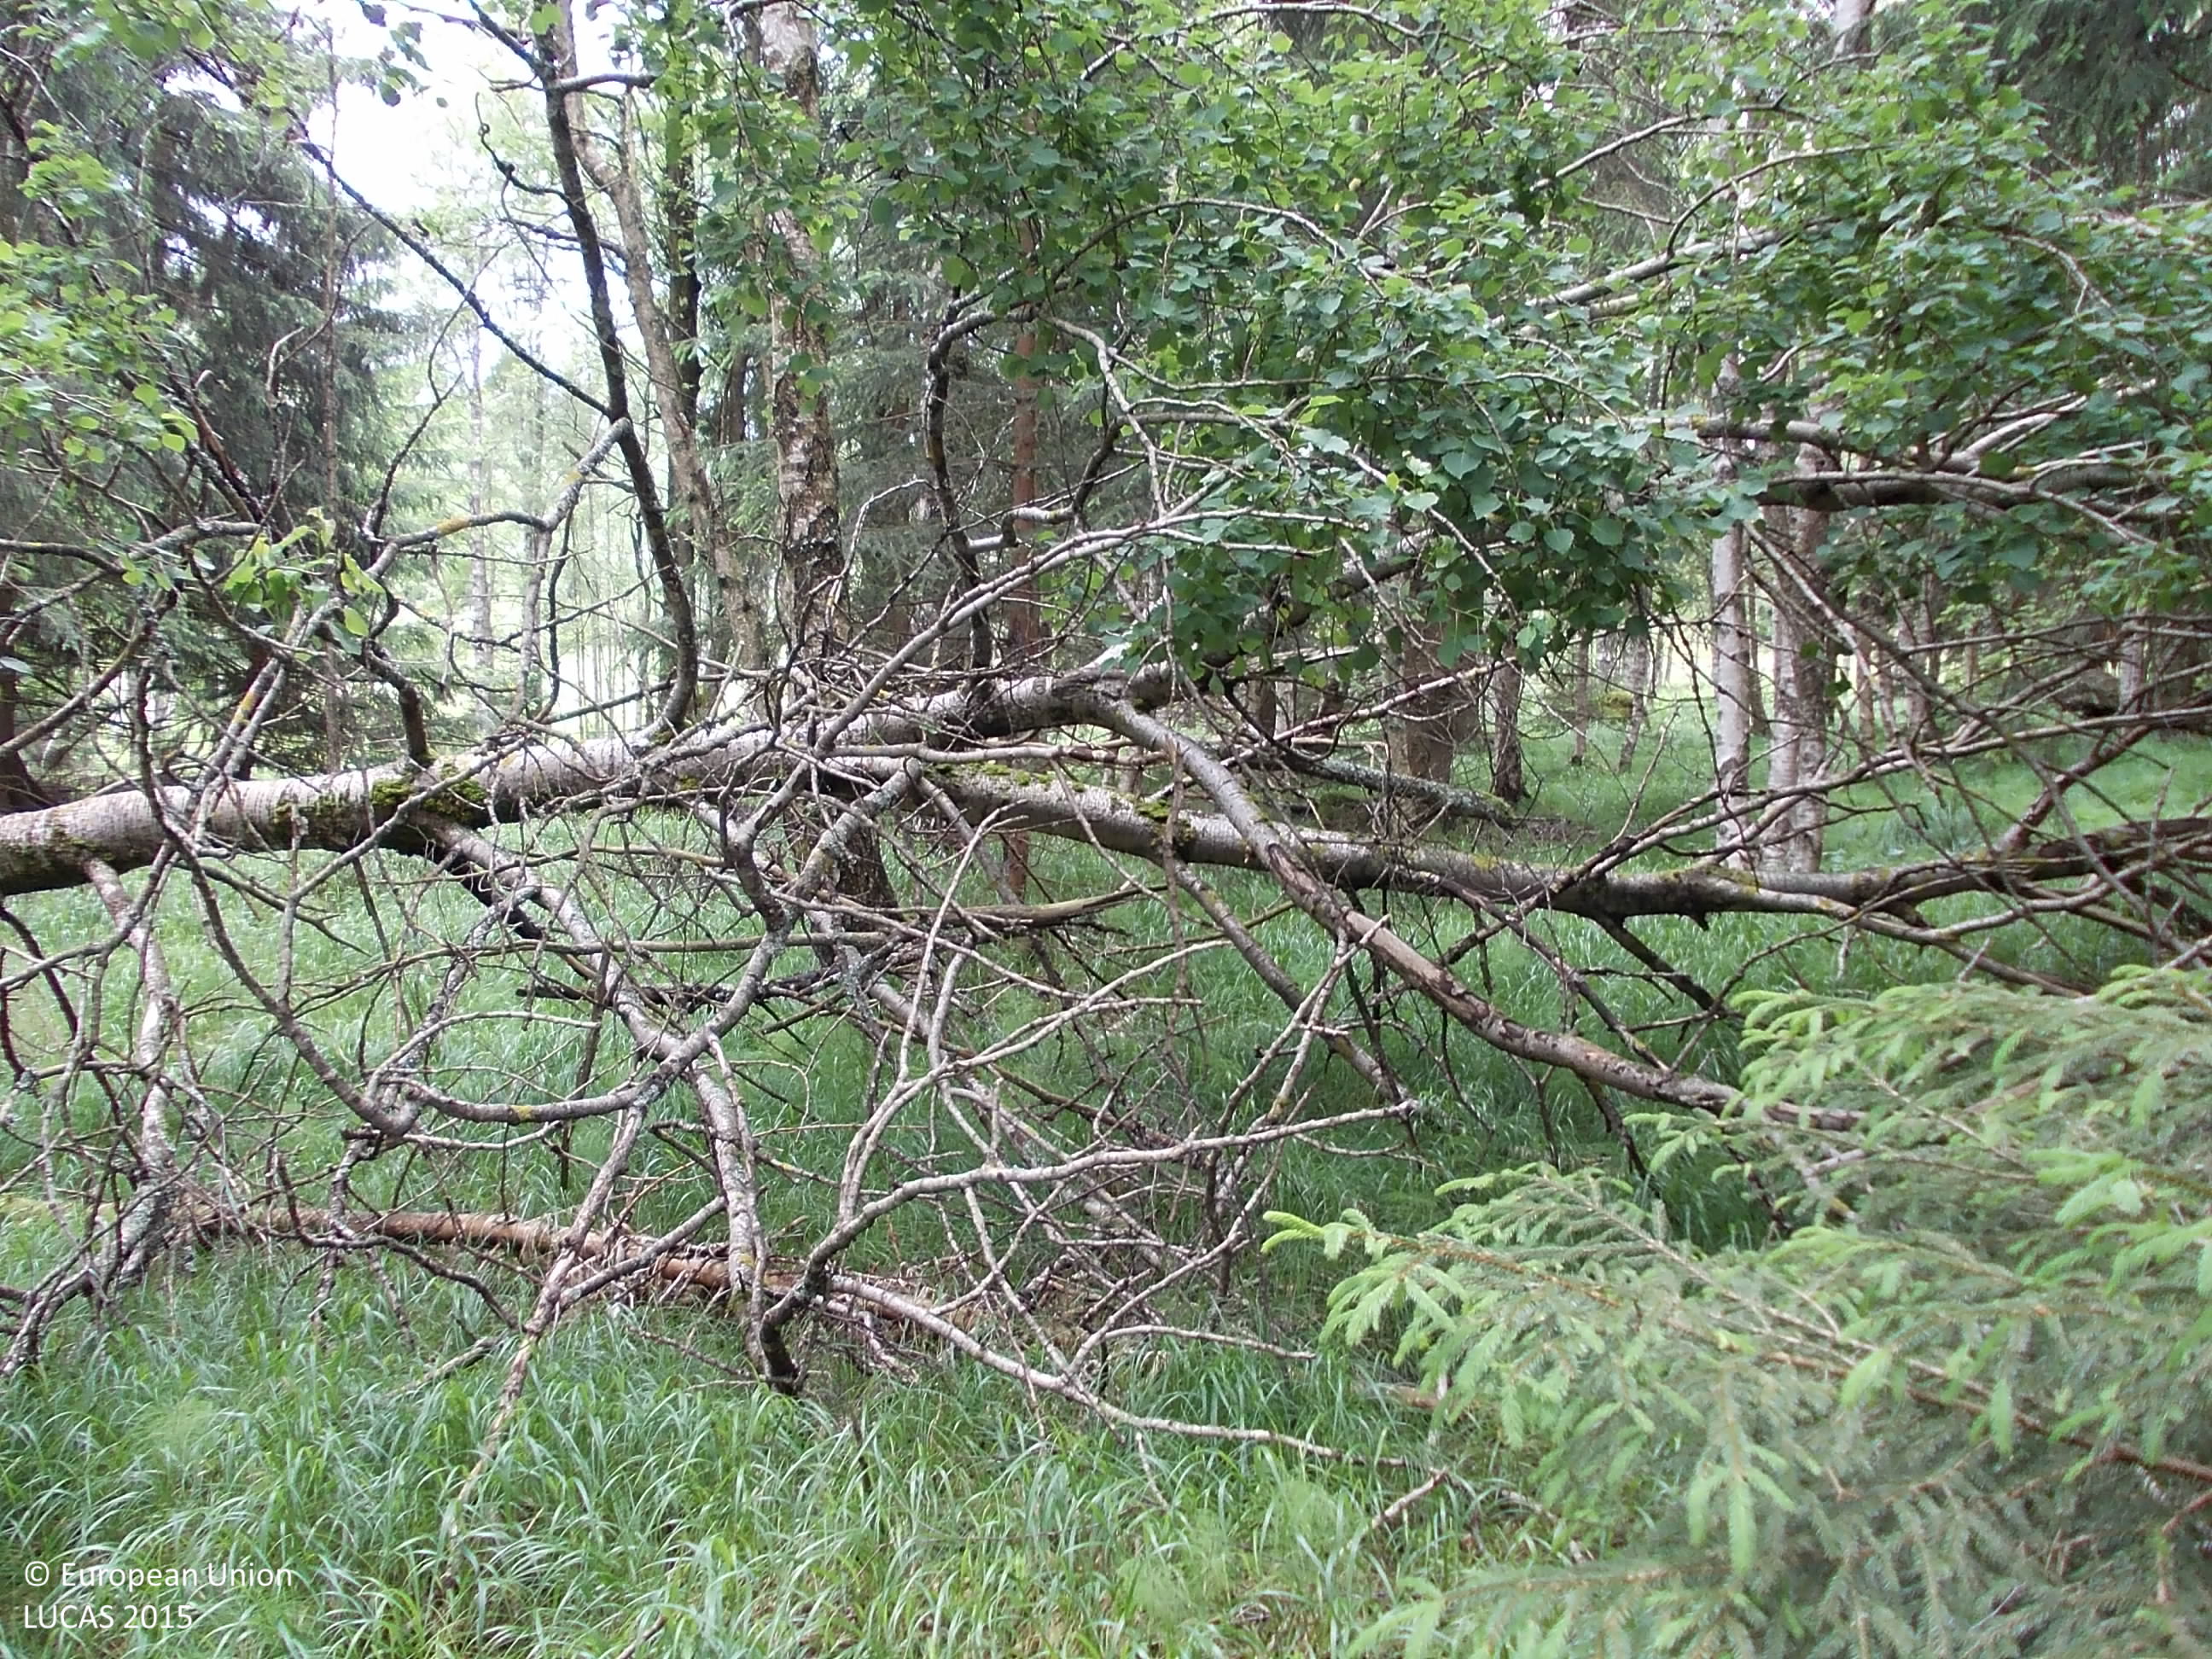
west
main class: Woodland
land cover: Spruce dominated mixed woodland
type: hemiboreal forest and nemoral coniferous forest and mixed broadleaved-coniferous forest
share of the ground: 50 - 75 %
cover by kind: coniferous forest trees 40 %, herbaceous plants 40 %, broadleaved forest trees 20 %
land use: Forestry
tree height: > 5 m
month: June
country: CZ
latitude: 48.8821
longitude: 13.6955
